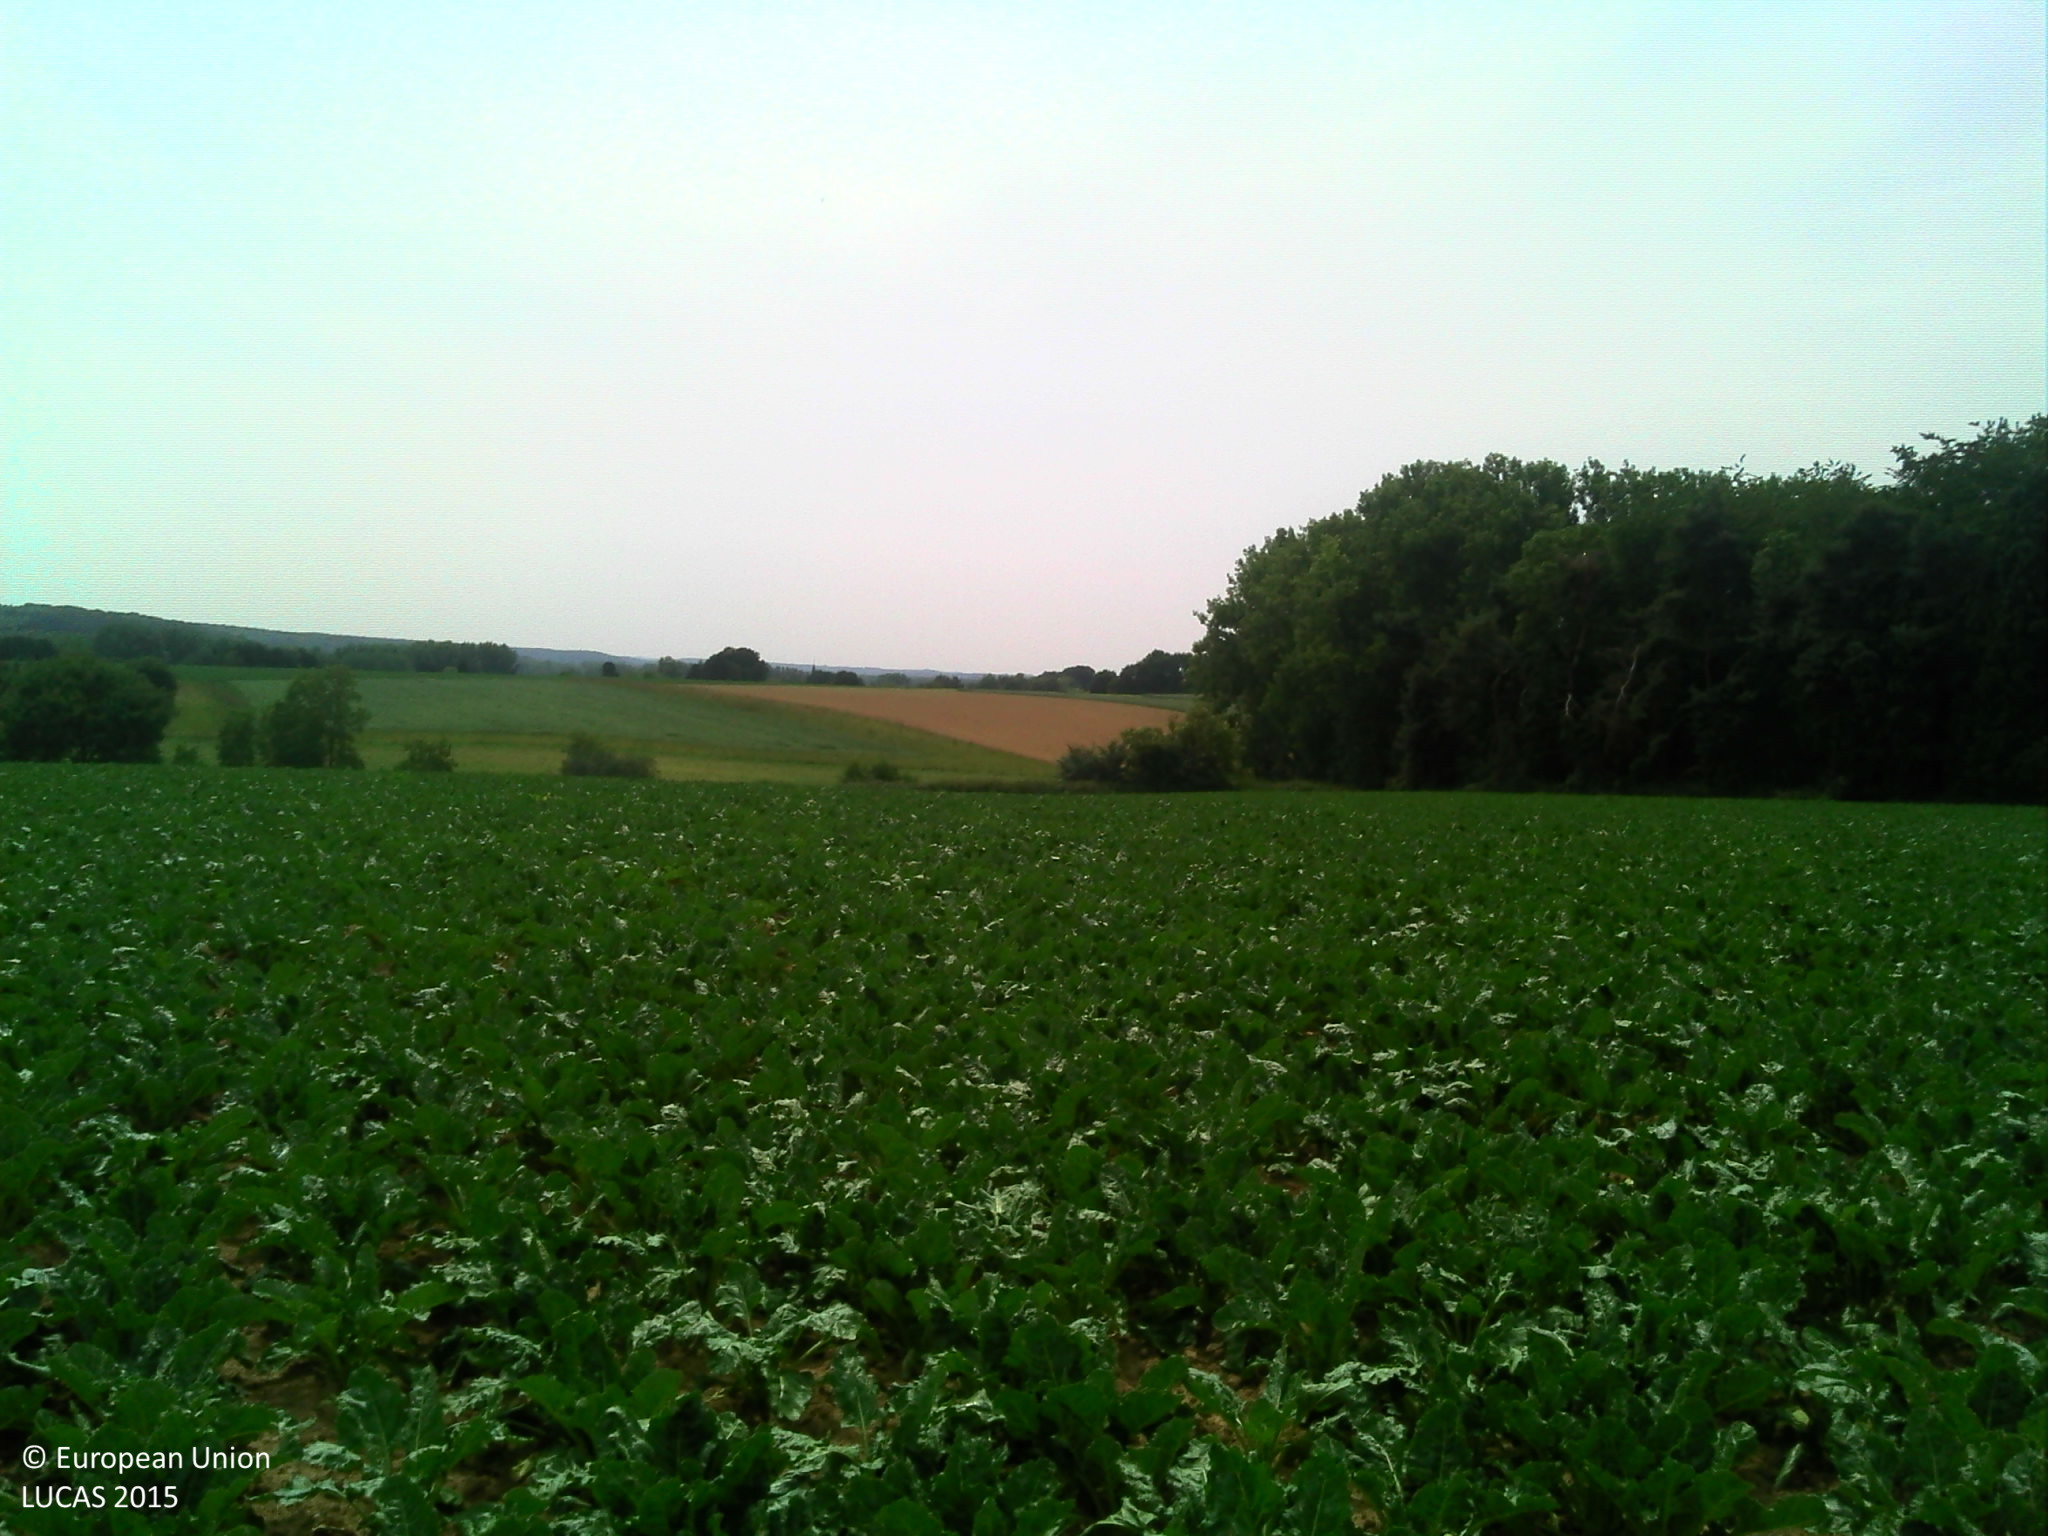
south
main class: Cropland
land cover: Sugar beet
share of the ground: > 75 %
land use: Agriculture (excluding fallow land and kitchen gardens)
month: June
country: BE
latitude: 50.8512
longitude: 4.6412
